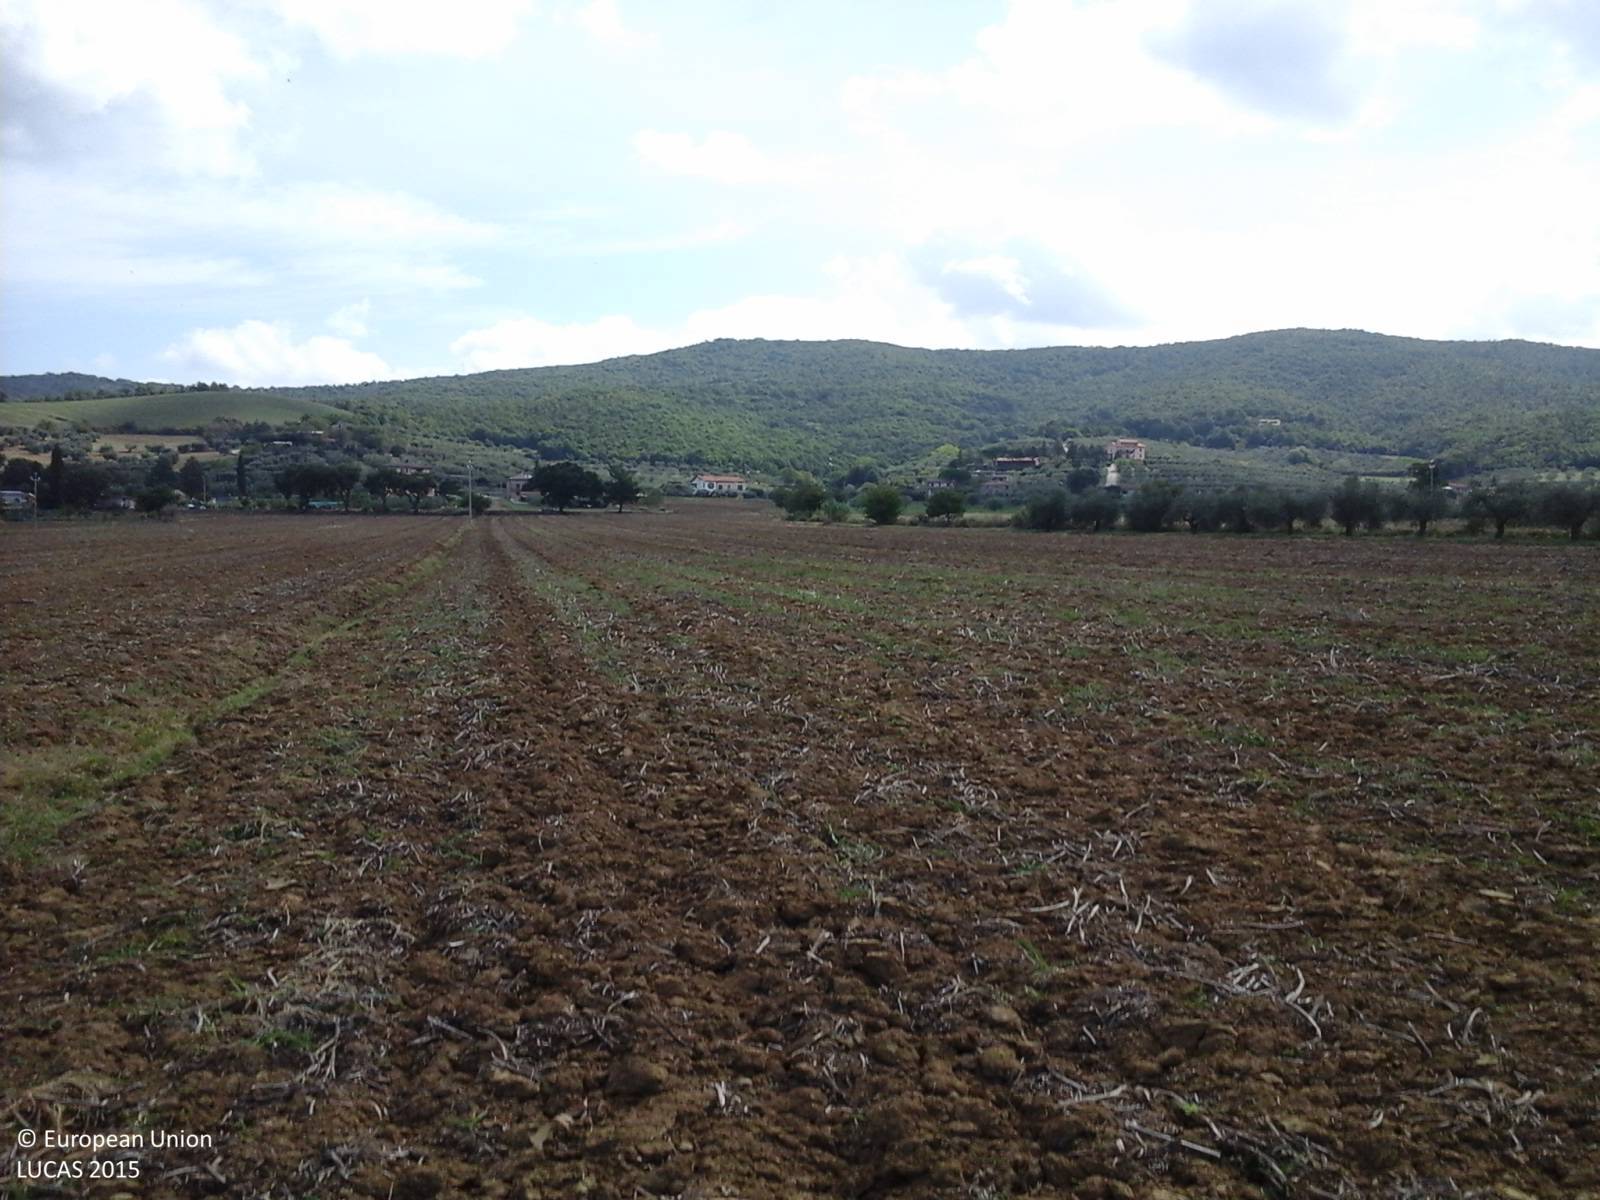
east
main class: Cropland
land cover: Dry pulses
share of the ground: < 10 %
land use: Agriculture (excluding fallow land and kitchen gardens)
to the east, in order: Dry pulses
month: September
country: IT
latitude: 43.0999
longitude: 12.1929
